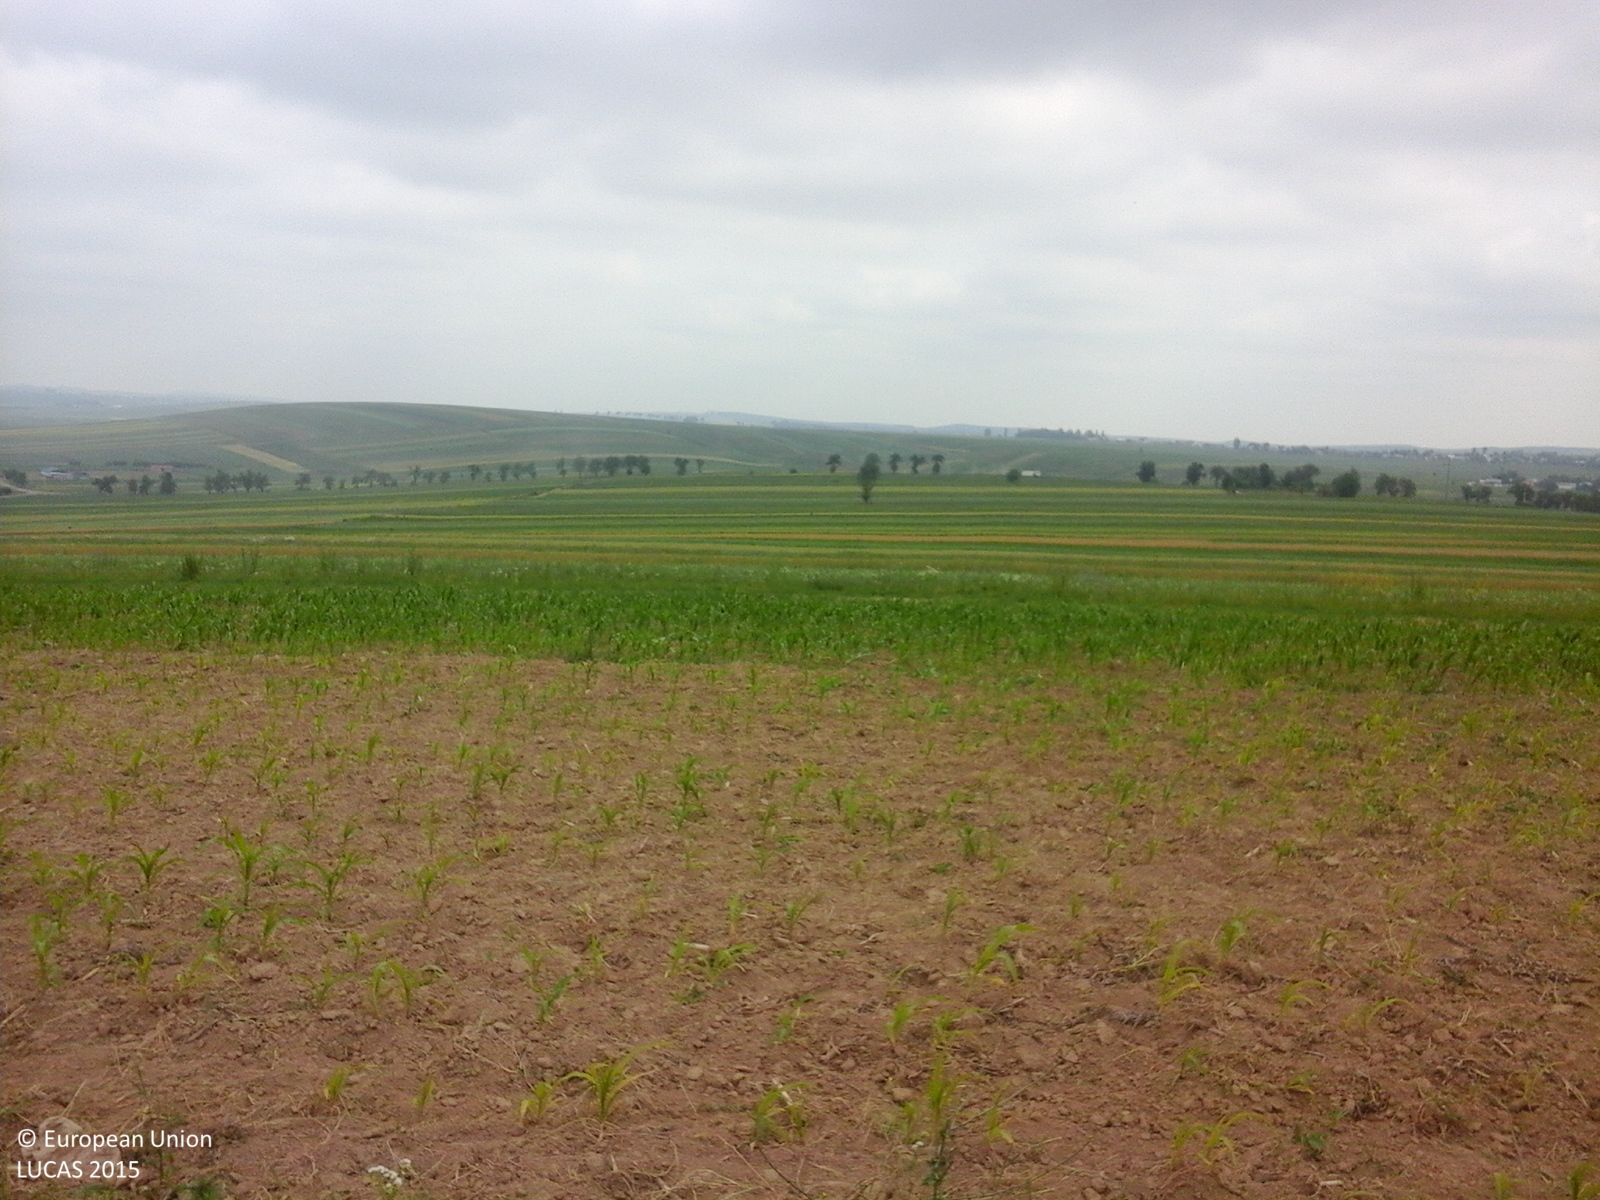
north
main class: Cropland
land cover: Oats
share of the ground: > 75 %
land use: Agriculture (excluding fallow land and kitchen gardens)
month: June
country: RO
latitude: 47.6396
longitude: 26.5564
